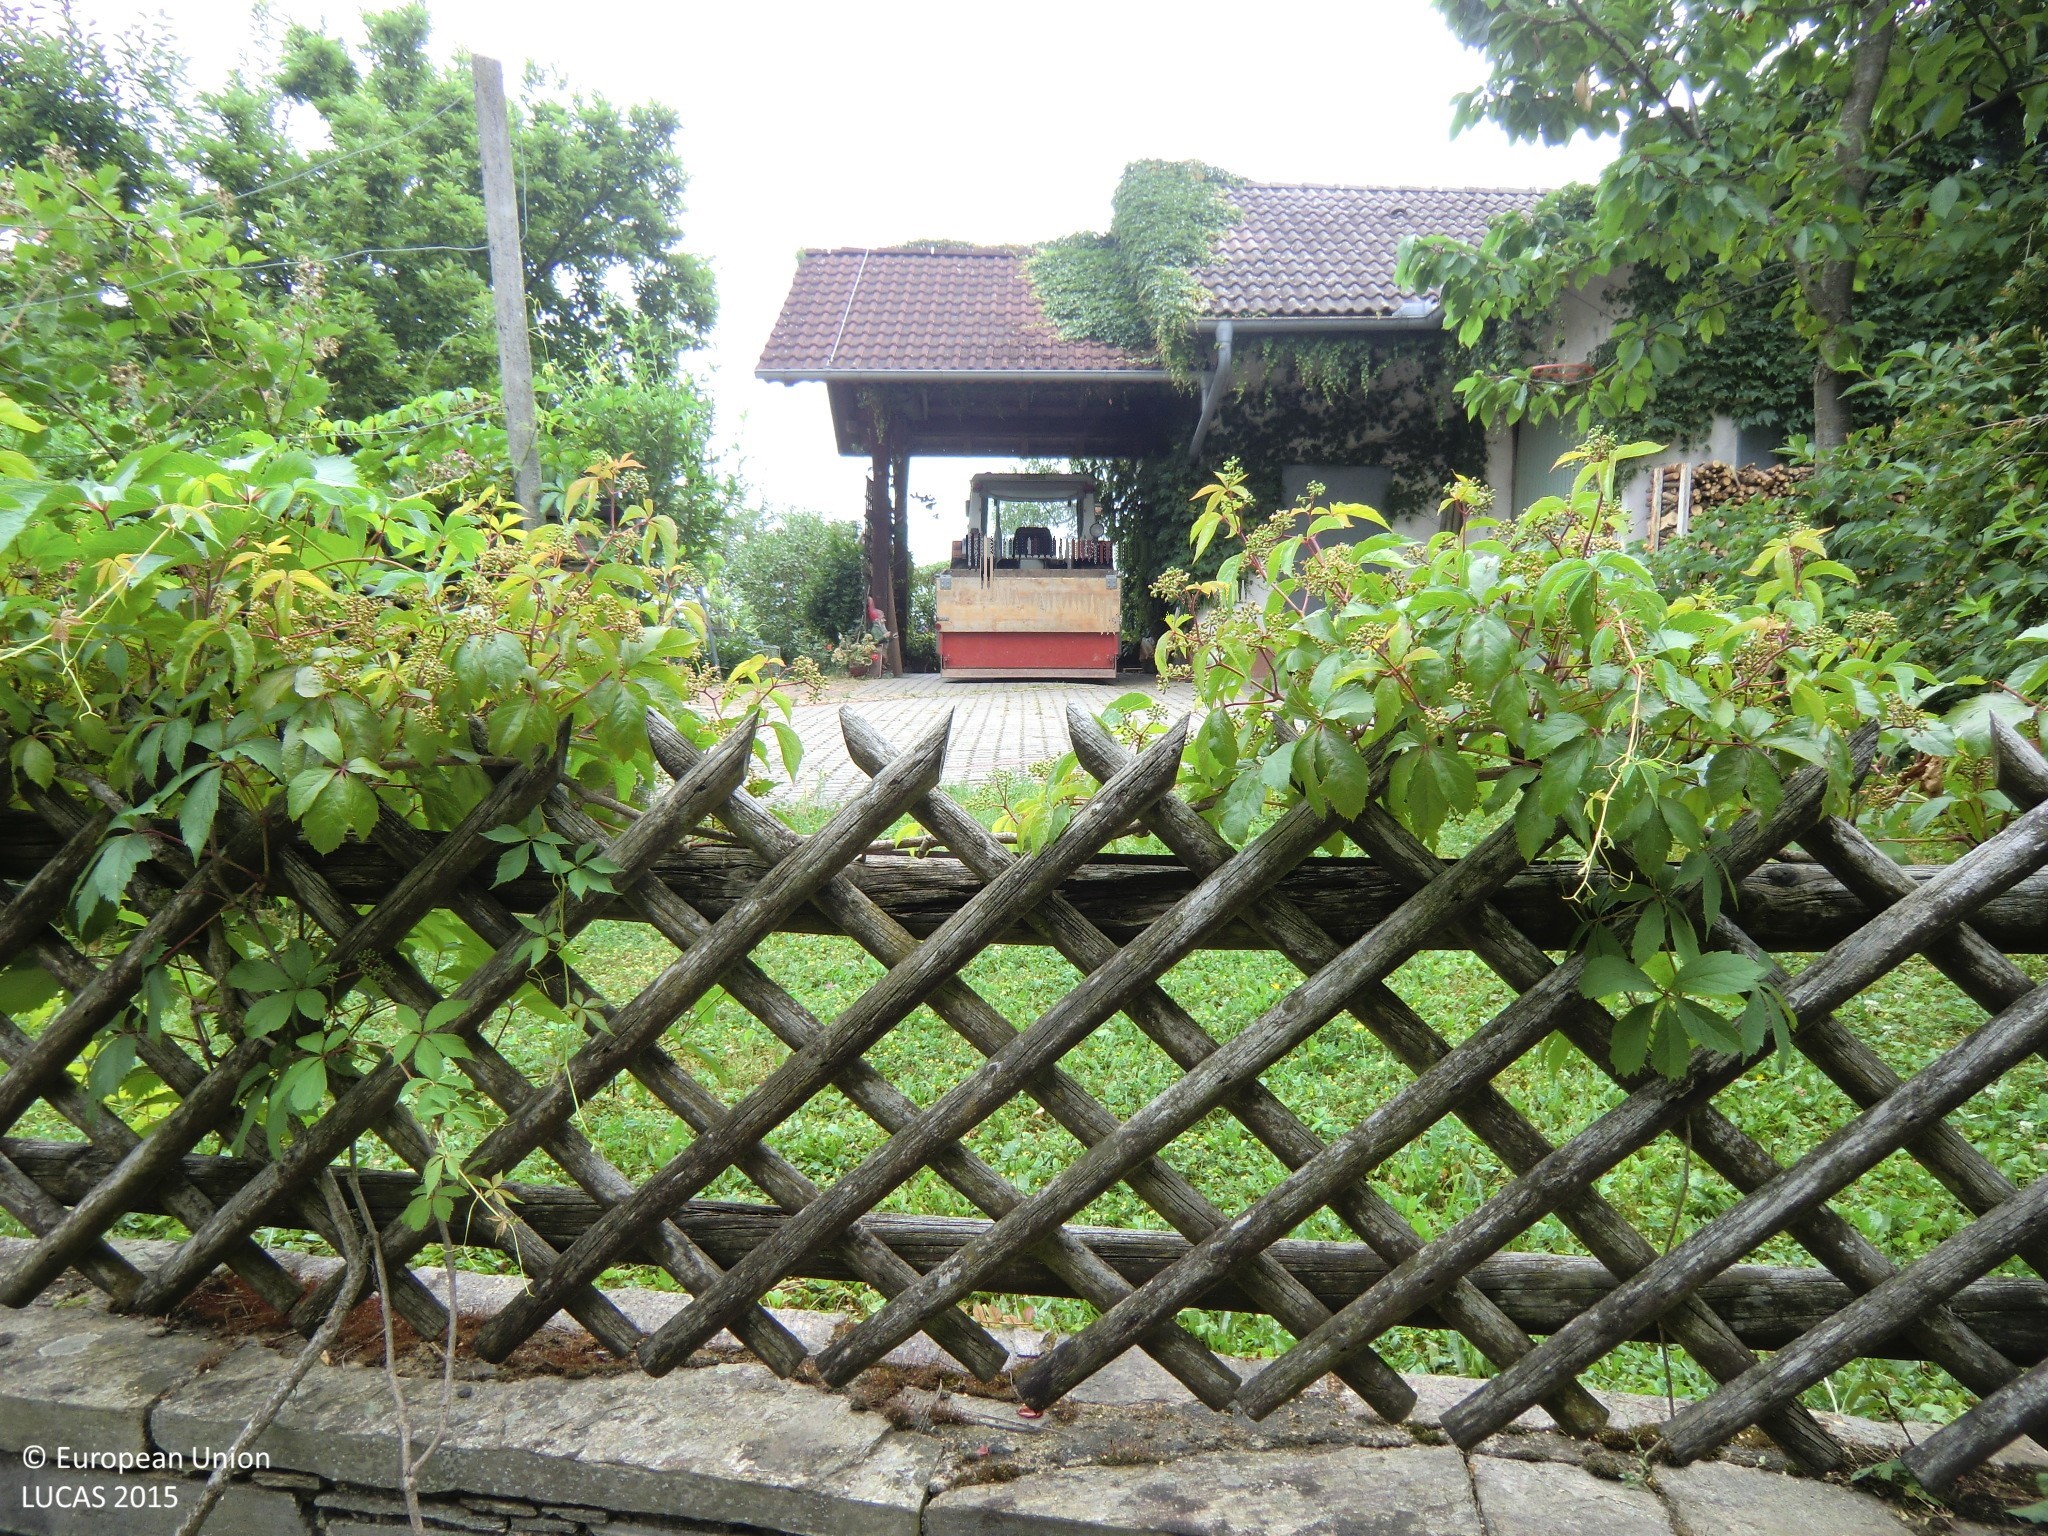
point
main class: Shrubland
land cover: Shrubland with sparse tree cover
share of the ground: > 75 %
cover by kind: herbaceous plants 55 %, shrubs 40 %, coniferous forest trees 5 %
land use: Residential
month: June
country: AT
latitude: 47.2458
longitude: 16.0395
